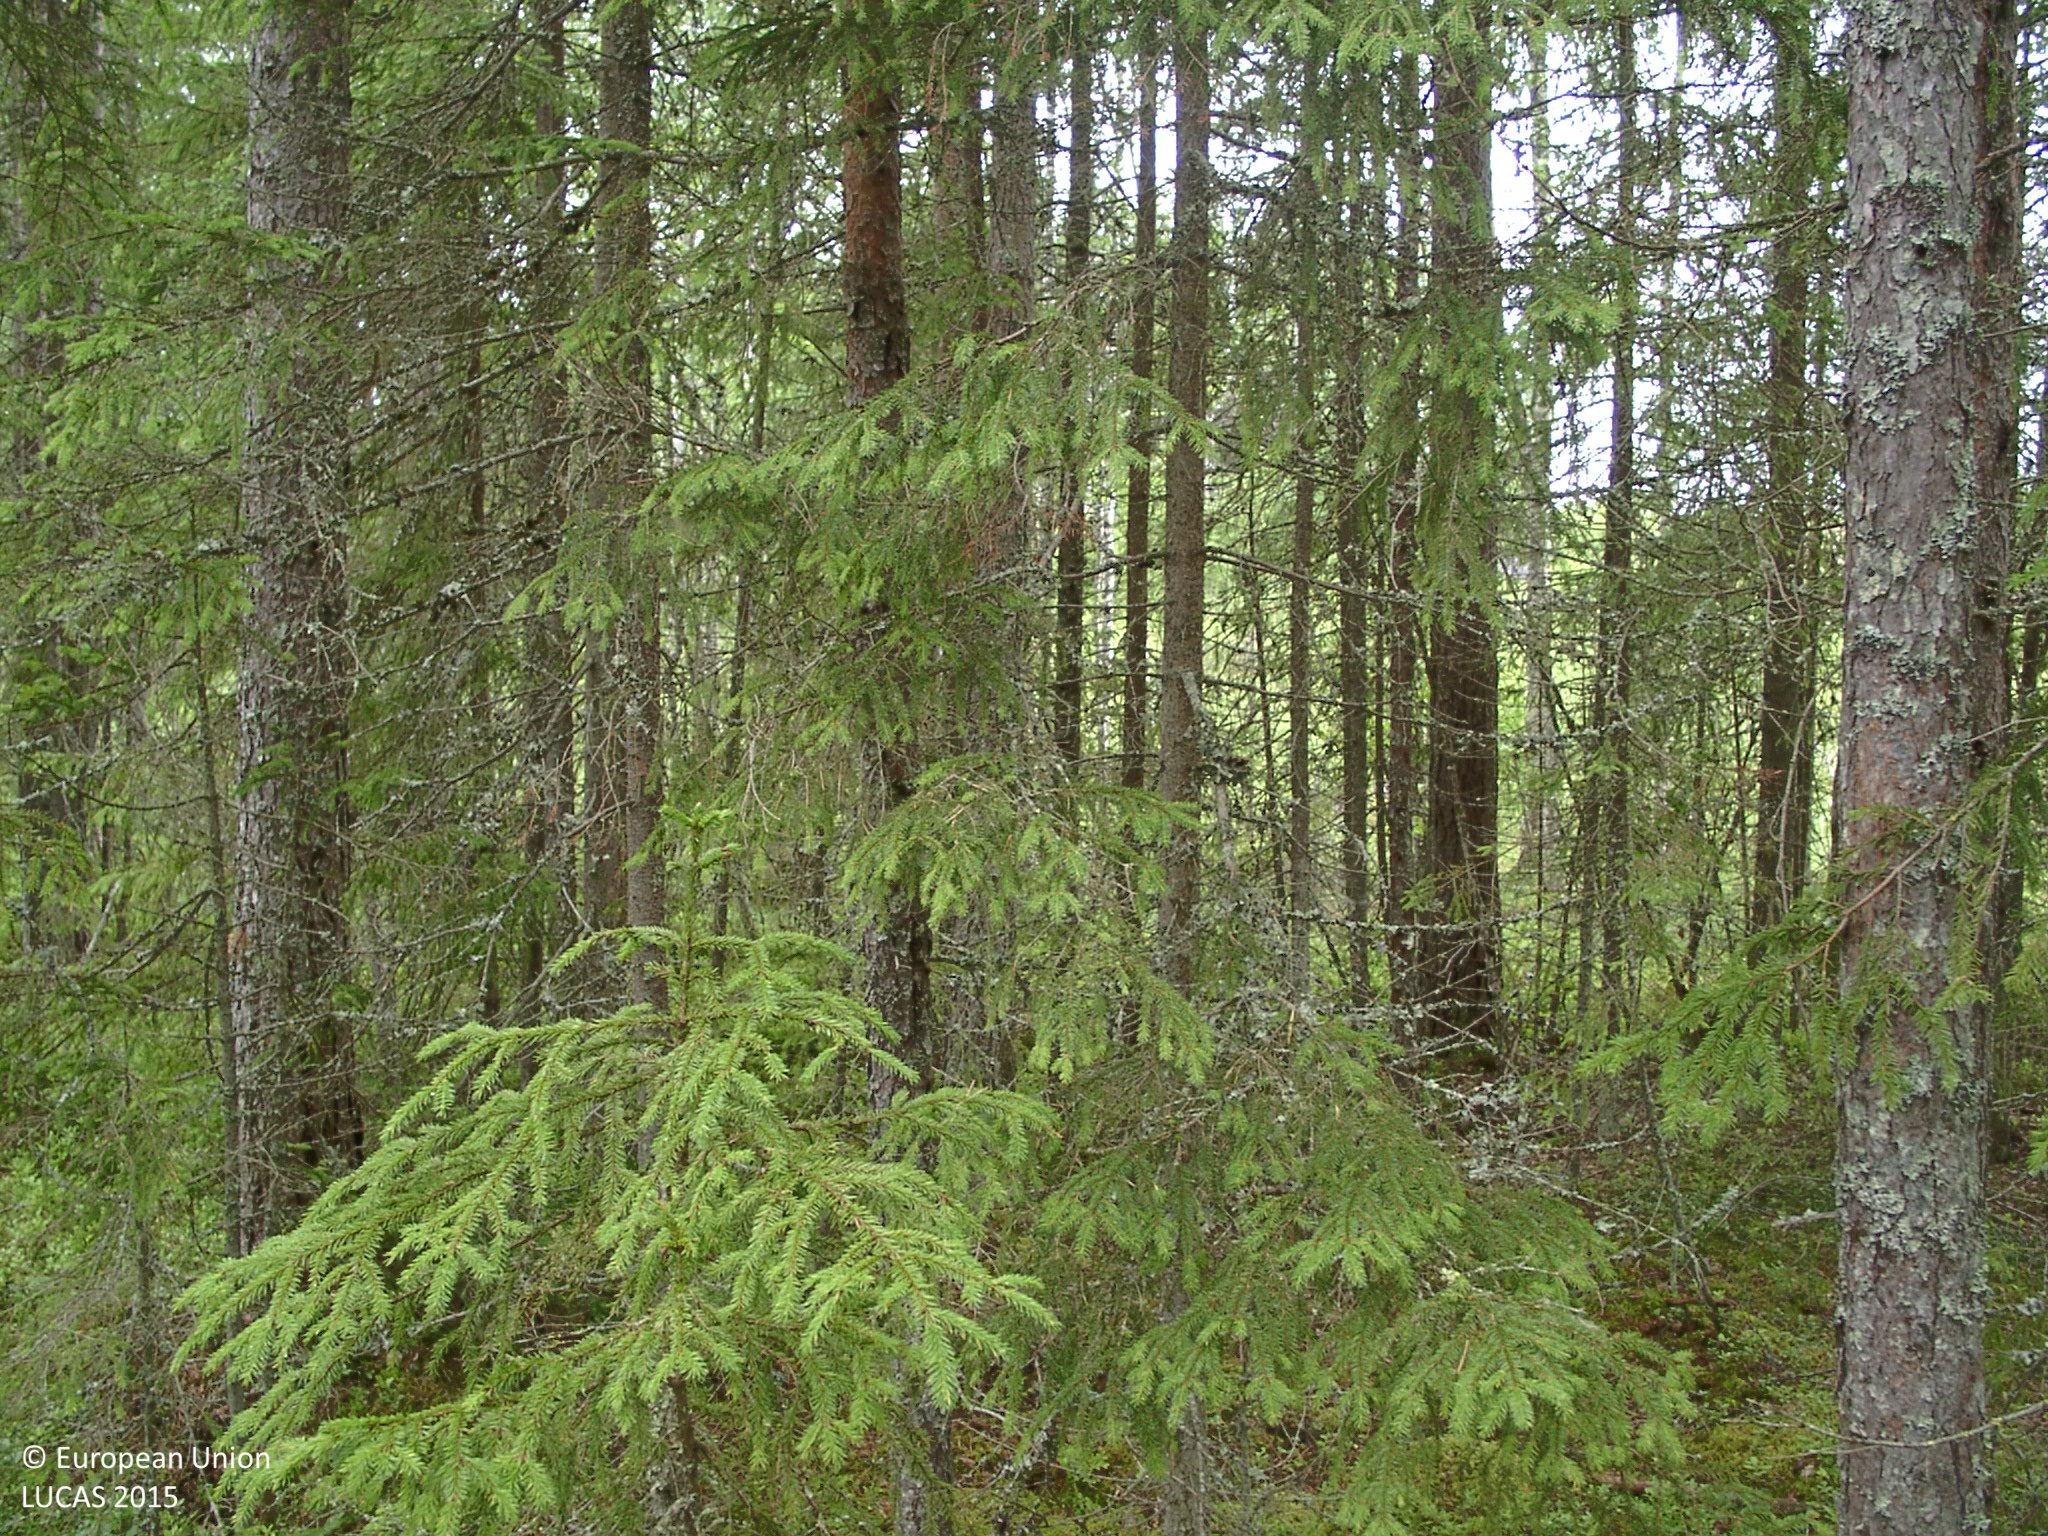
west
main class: Woodland
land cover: Other mixed woodland
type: boreal forest
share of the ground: > 75 %
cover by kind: coniferous forest trees 50 %, broadleaved forest trees 25 %, shrubs 10 %, lichens and mosses 10 %, herbaceous plants 5 %
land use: Semi-natural and natural areas not in use
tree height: > 5 m
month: July
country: FI
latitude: 62.1484
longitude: 25.3658
